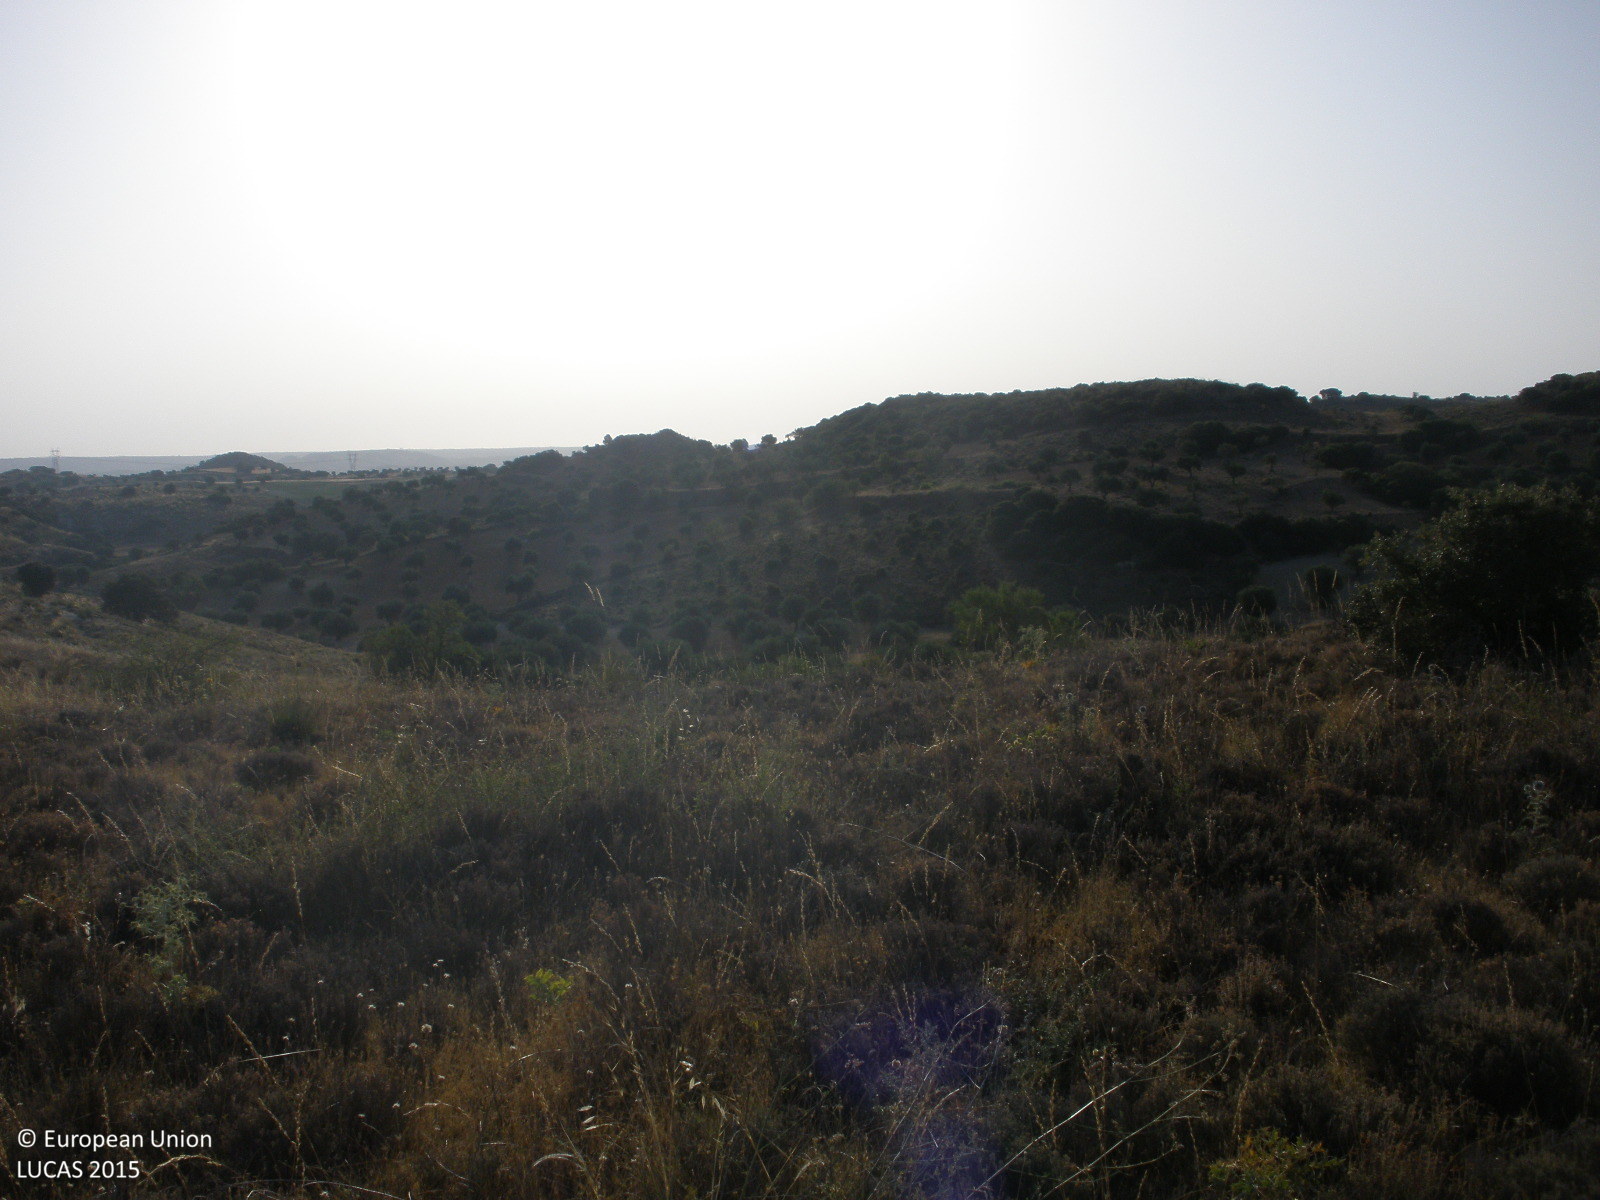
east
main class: Shrubland
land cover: Shrubland without tree cover
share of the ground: > 75 %
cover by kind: shrubs 75 %, herbaceous plants 25 %
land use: Semi-natural and natural areas not in use
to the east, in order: Shrubland without tree cover; Olive groves; Shrubland without tree cover; Olive groves; Grass margins; Tracks; Grass margins; Olive groves; Grass margins; Olive groves; Shrubland with sparse tree cover; Broadleaved woodland
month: July
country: ES
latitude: 40.1879
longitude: -3.3851
